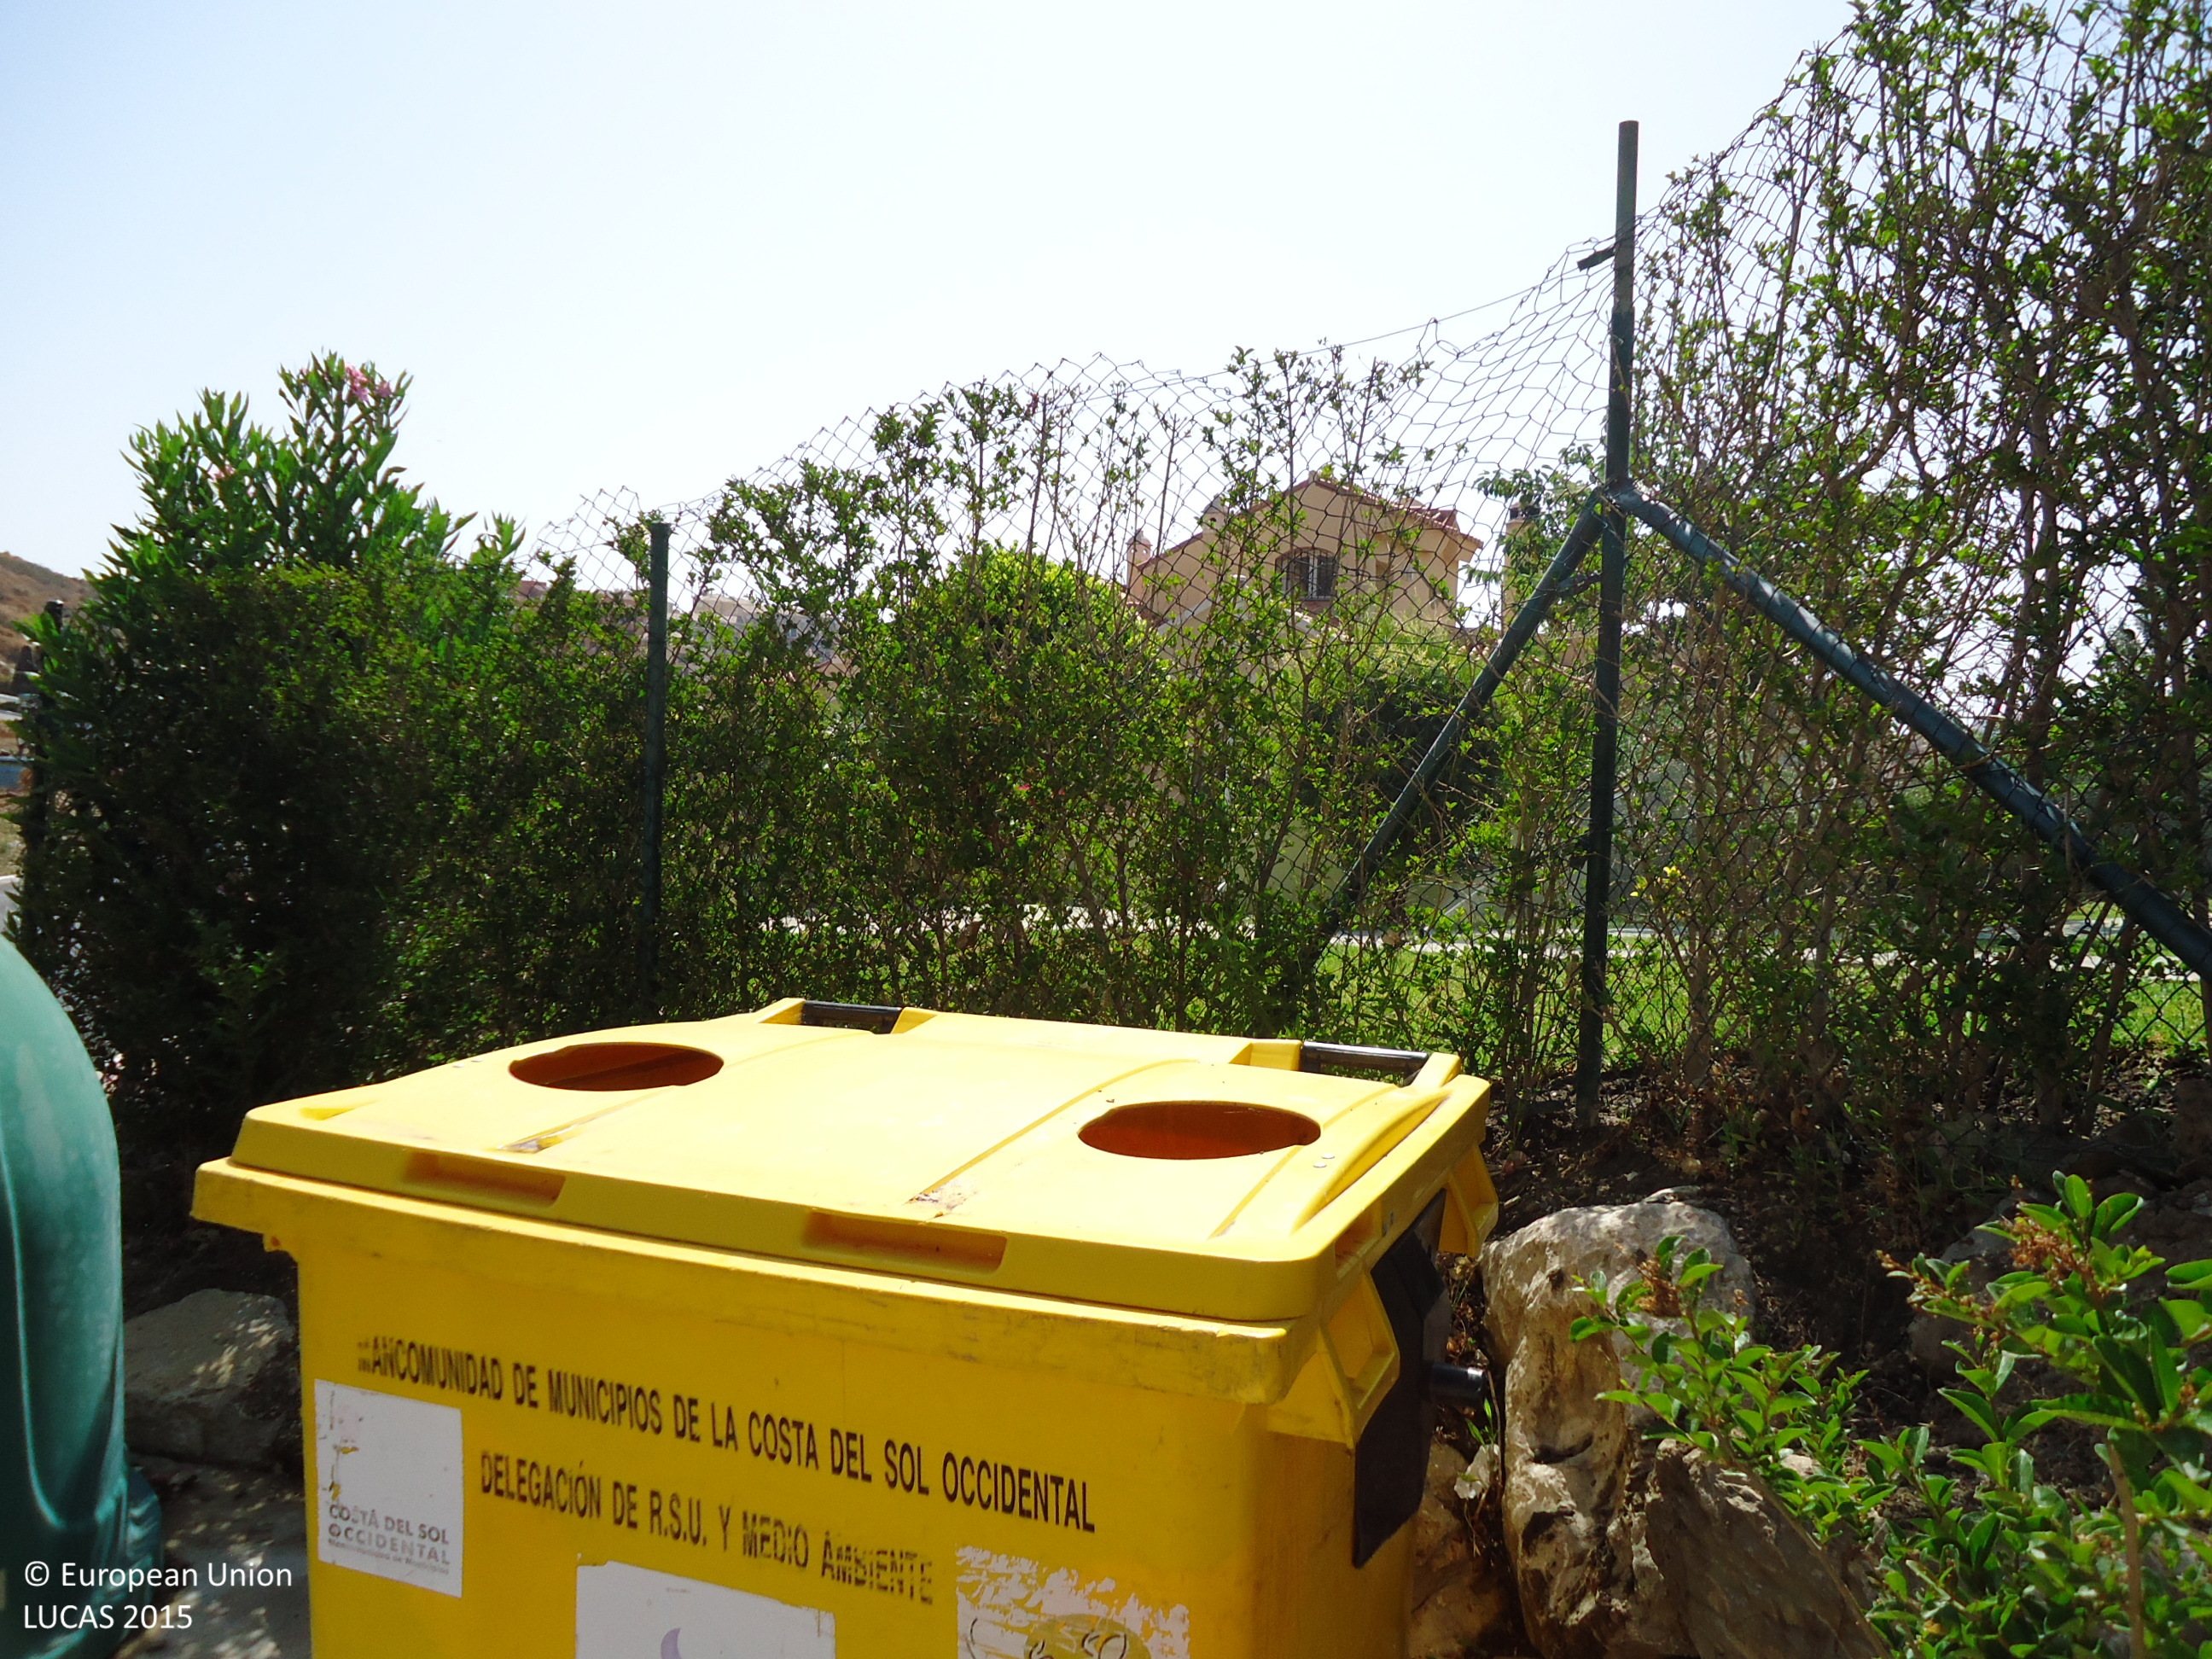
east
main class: Grassland
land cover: Grassland with sparse tree/shrub cover
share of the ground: > 75 %
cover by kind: herbaceous plants 95 %, broadleaved forest trees 5 %
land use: Residential
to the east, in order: Grassland with sparse tree/shrub cover; Artificial constructions in urban areas; Grassland with sparse tree/shrub cover
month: July
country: ES
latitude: 36.5039
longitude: -4.7157
